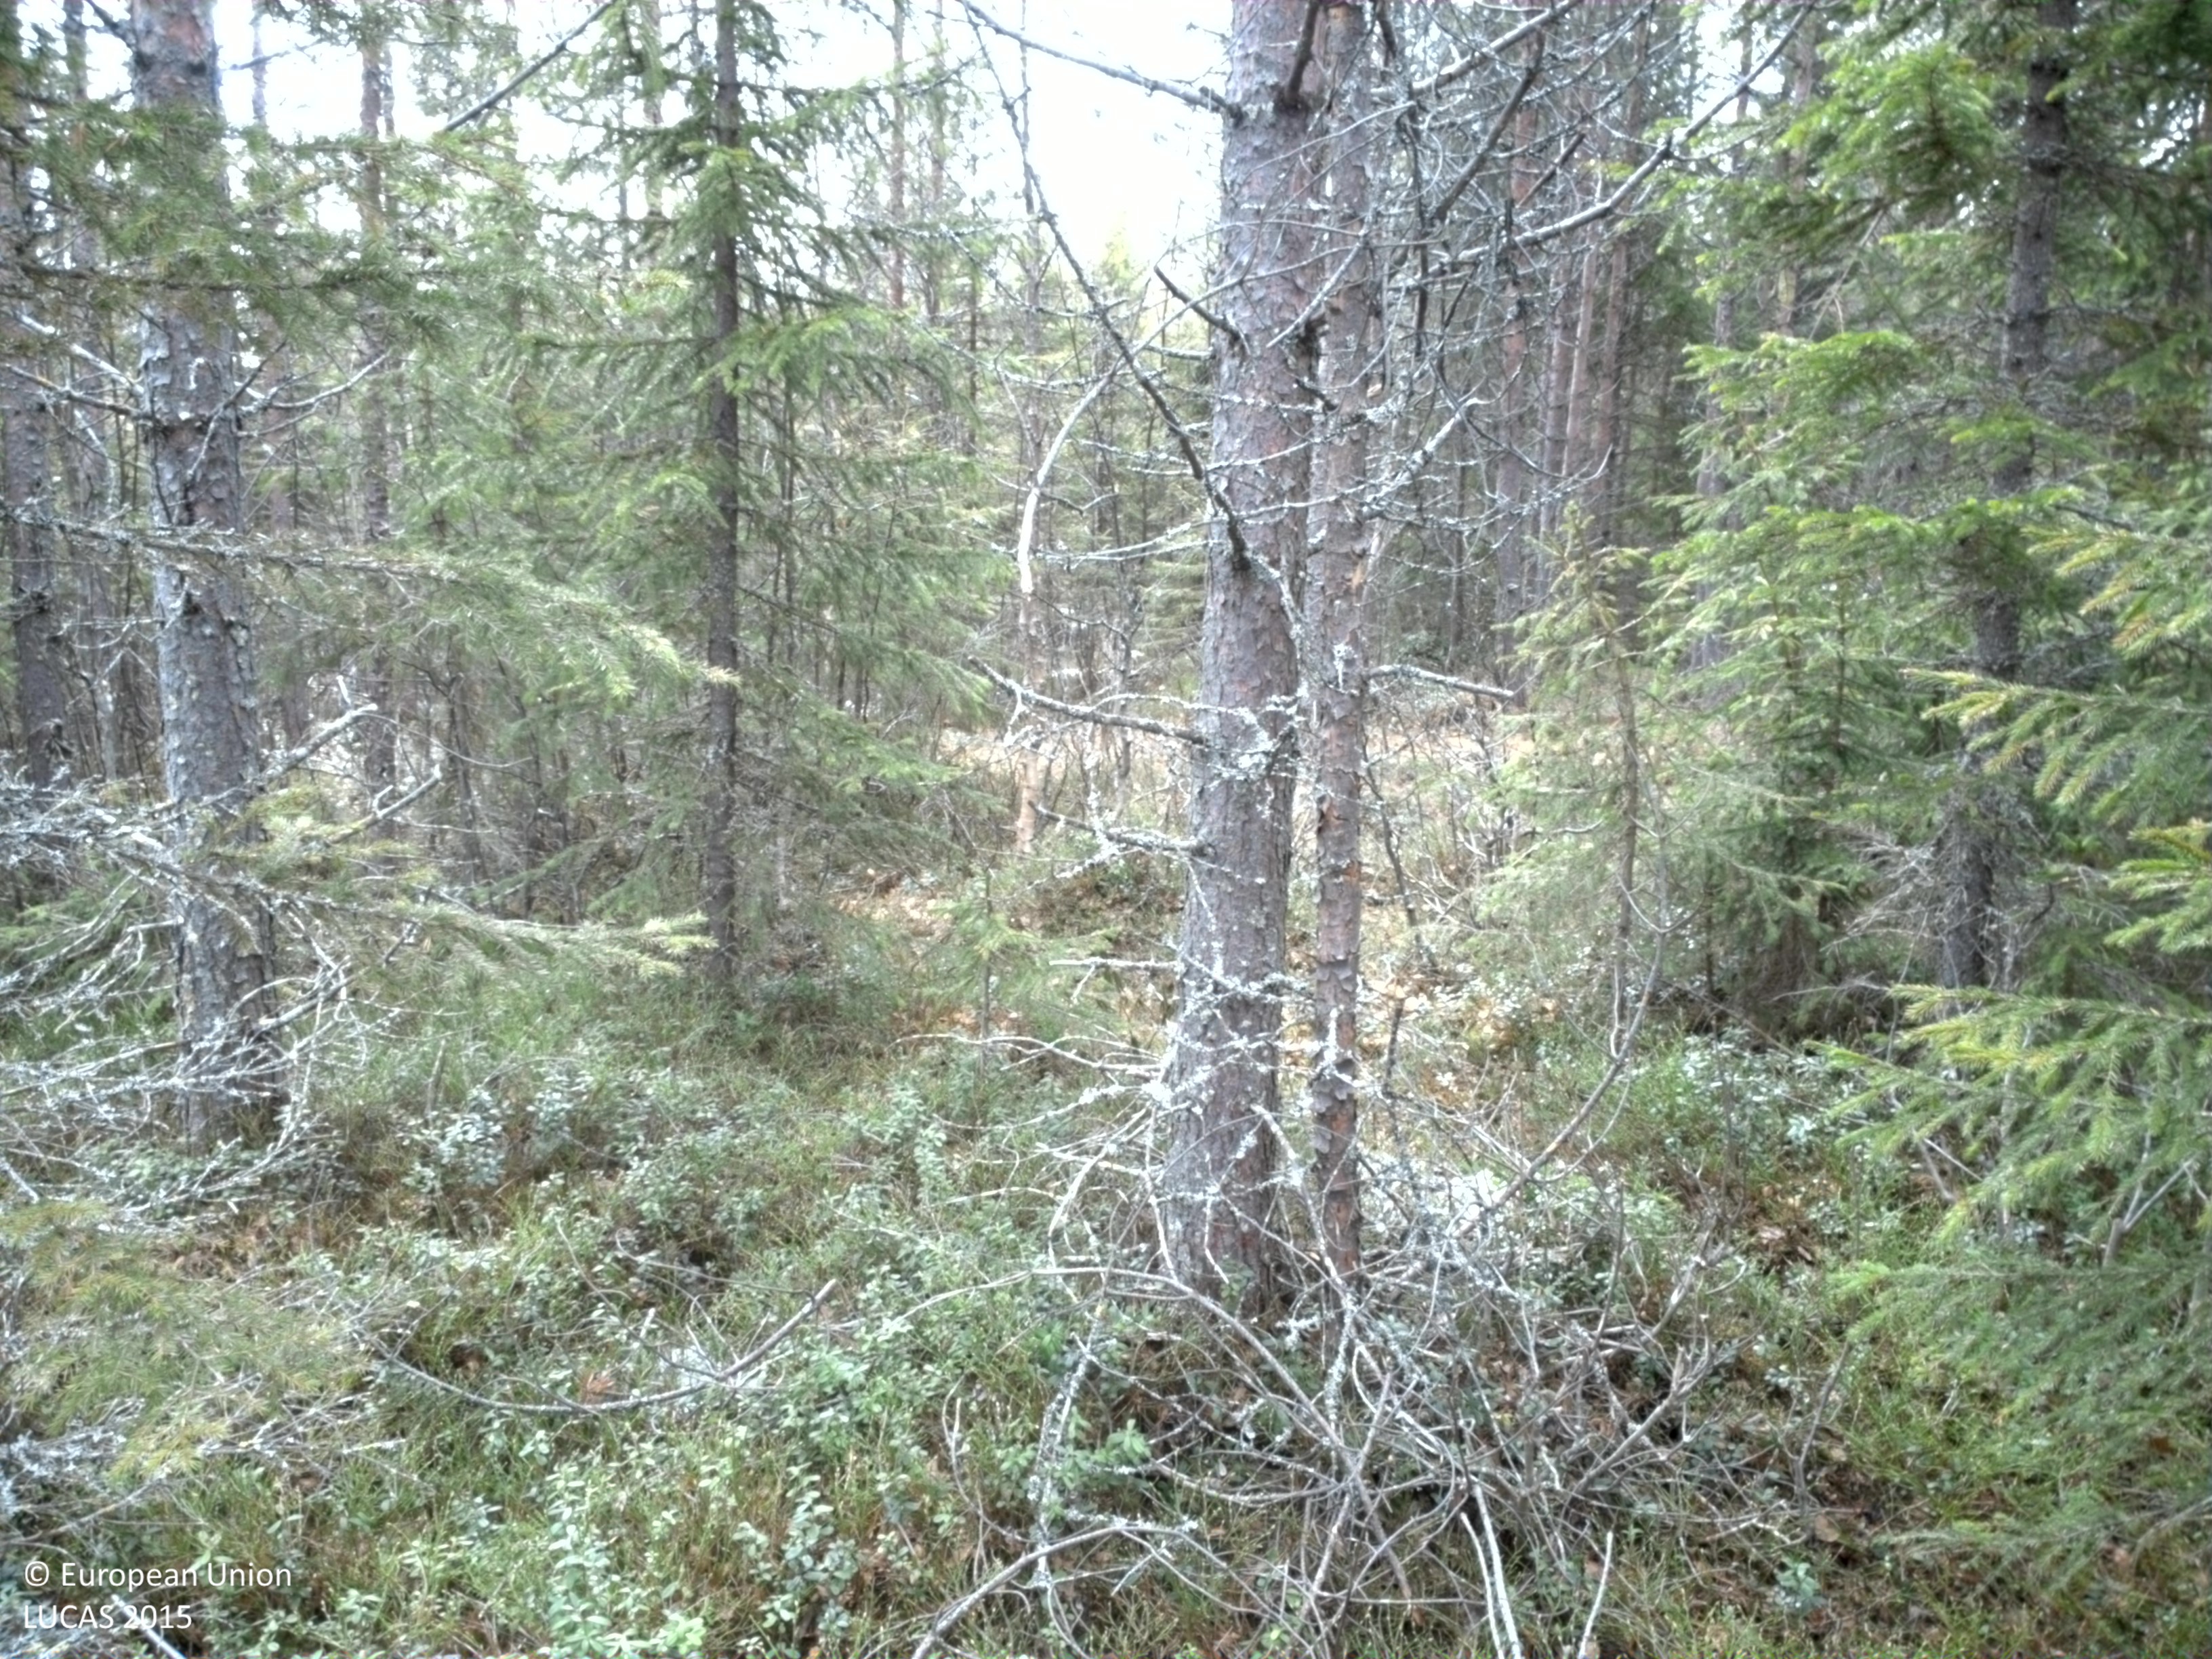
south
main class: Woodland
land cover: Other coniferous woodland
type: boreal forest
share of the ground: > 75 %
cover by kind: coniferous forest trees 75 %, shrubs 20 %, broadleaved forest trees 5 %
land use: Forestry
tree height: > 5 m
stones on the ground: < 10 %
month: May
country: SE
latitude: 66.1662
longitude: 23.8100
